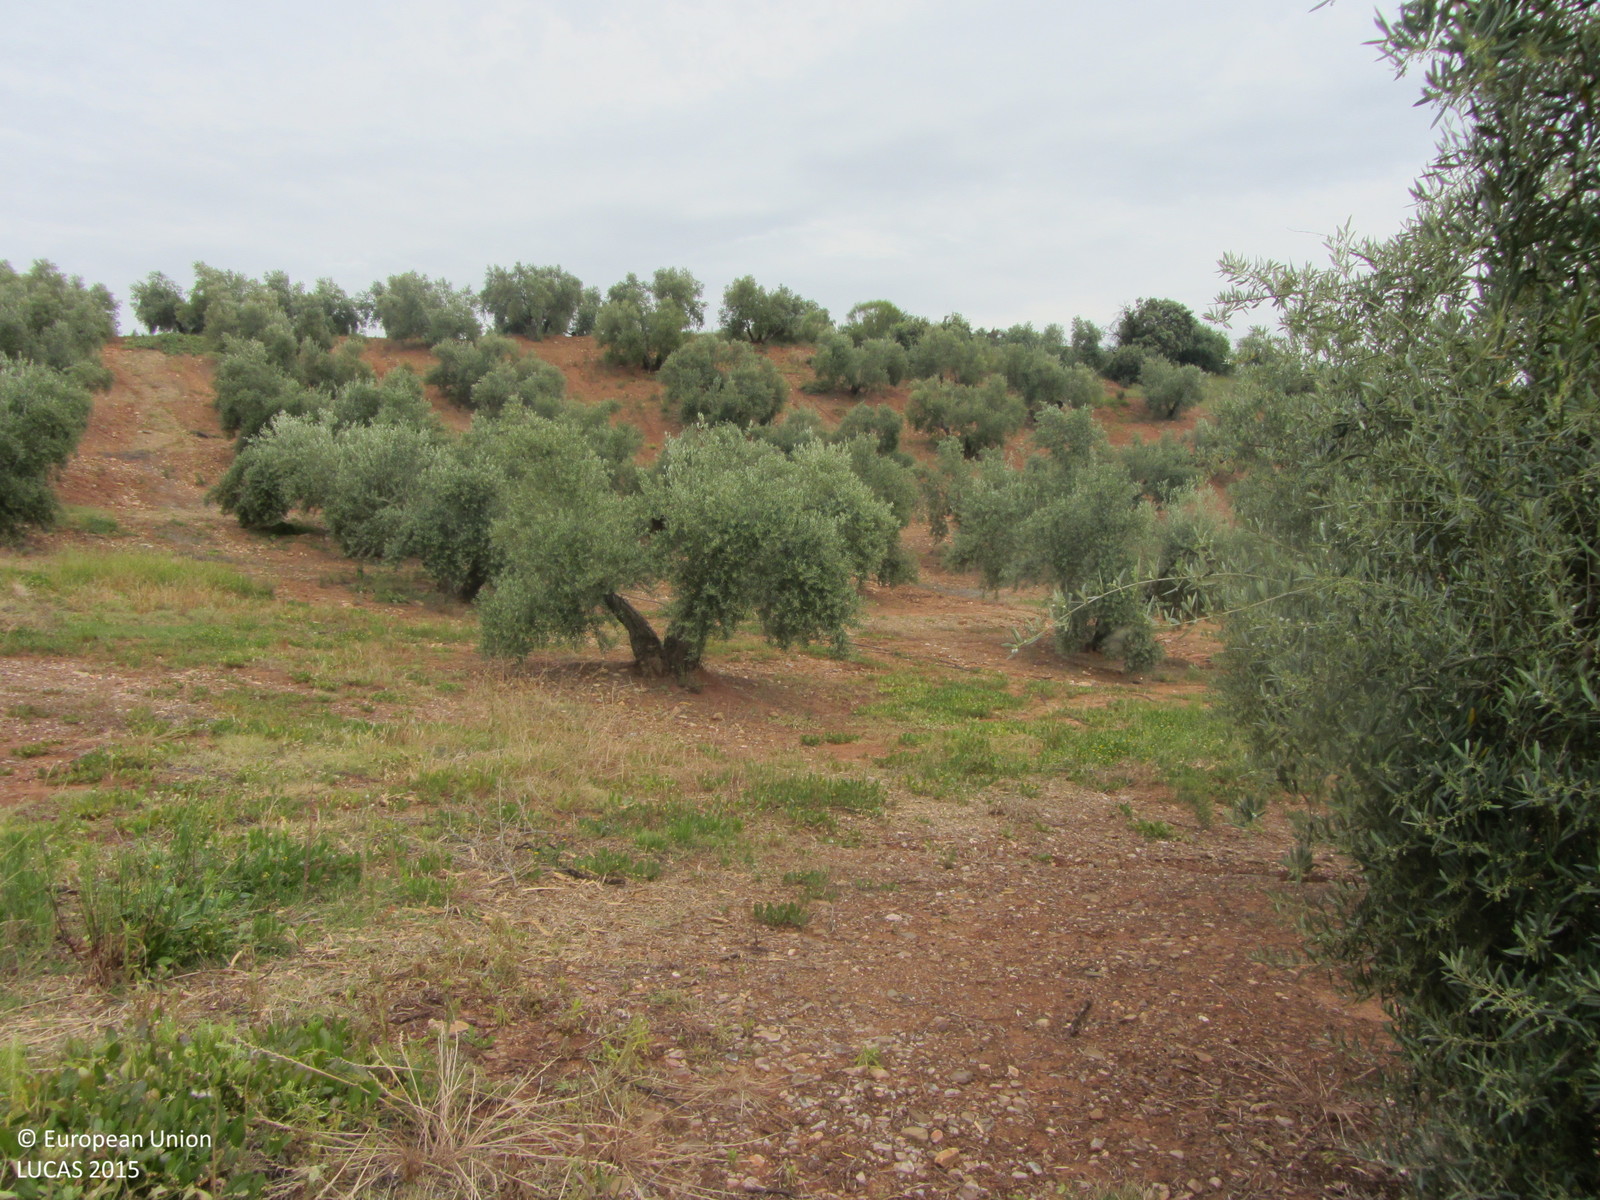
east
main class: Cropland
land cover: Olive groves
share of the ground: 25 - 50 %
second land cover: Spontaneously vegetated surfaces
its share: 50 - 75 %
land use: Agriculture (excluding fallow land and kitchen gardens)
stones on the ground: > 50 %
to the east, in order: Olive groves; Spontaneously vegetated surfaces; Shruby margins; Olive groves
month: May
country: ES
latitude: 38.2636
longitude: -2.9949
